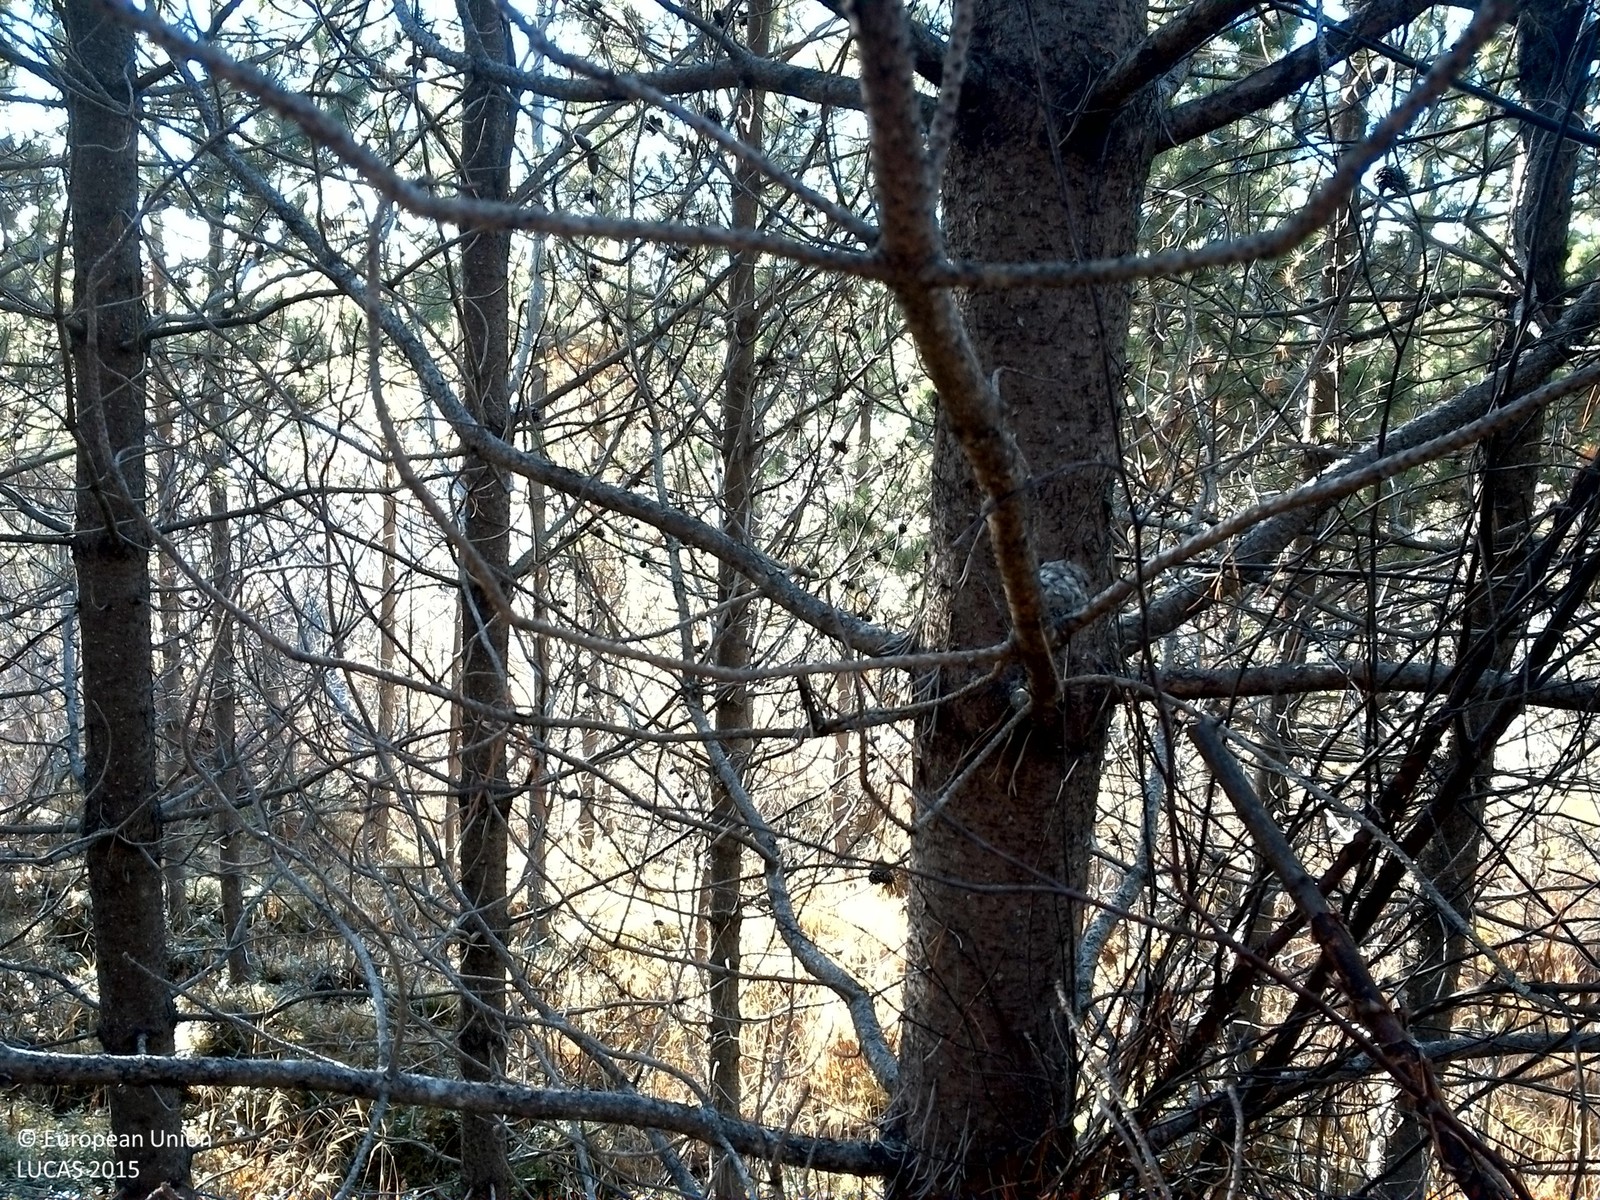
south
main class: Woodland
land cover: Pine dominated coniferous woodland
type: exotic forest
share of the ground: 25 - 50 %
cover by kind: coniferous forest trees 40 %, shrubs 35 %, lichens and mosses 20 %, herbaceous plants 5 %
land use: Forestry
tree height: > 5 m
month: October
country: SE
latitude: 64.4664
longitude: 15.4805
